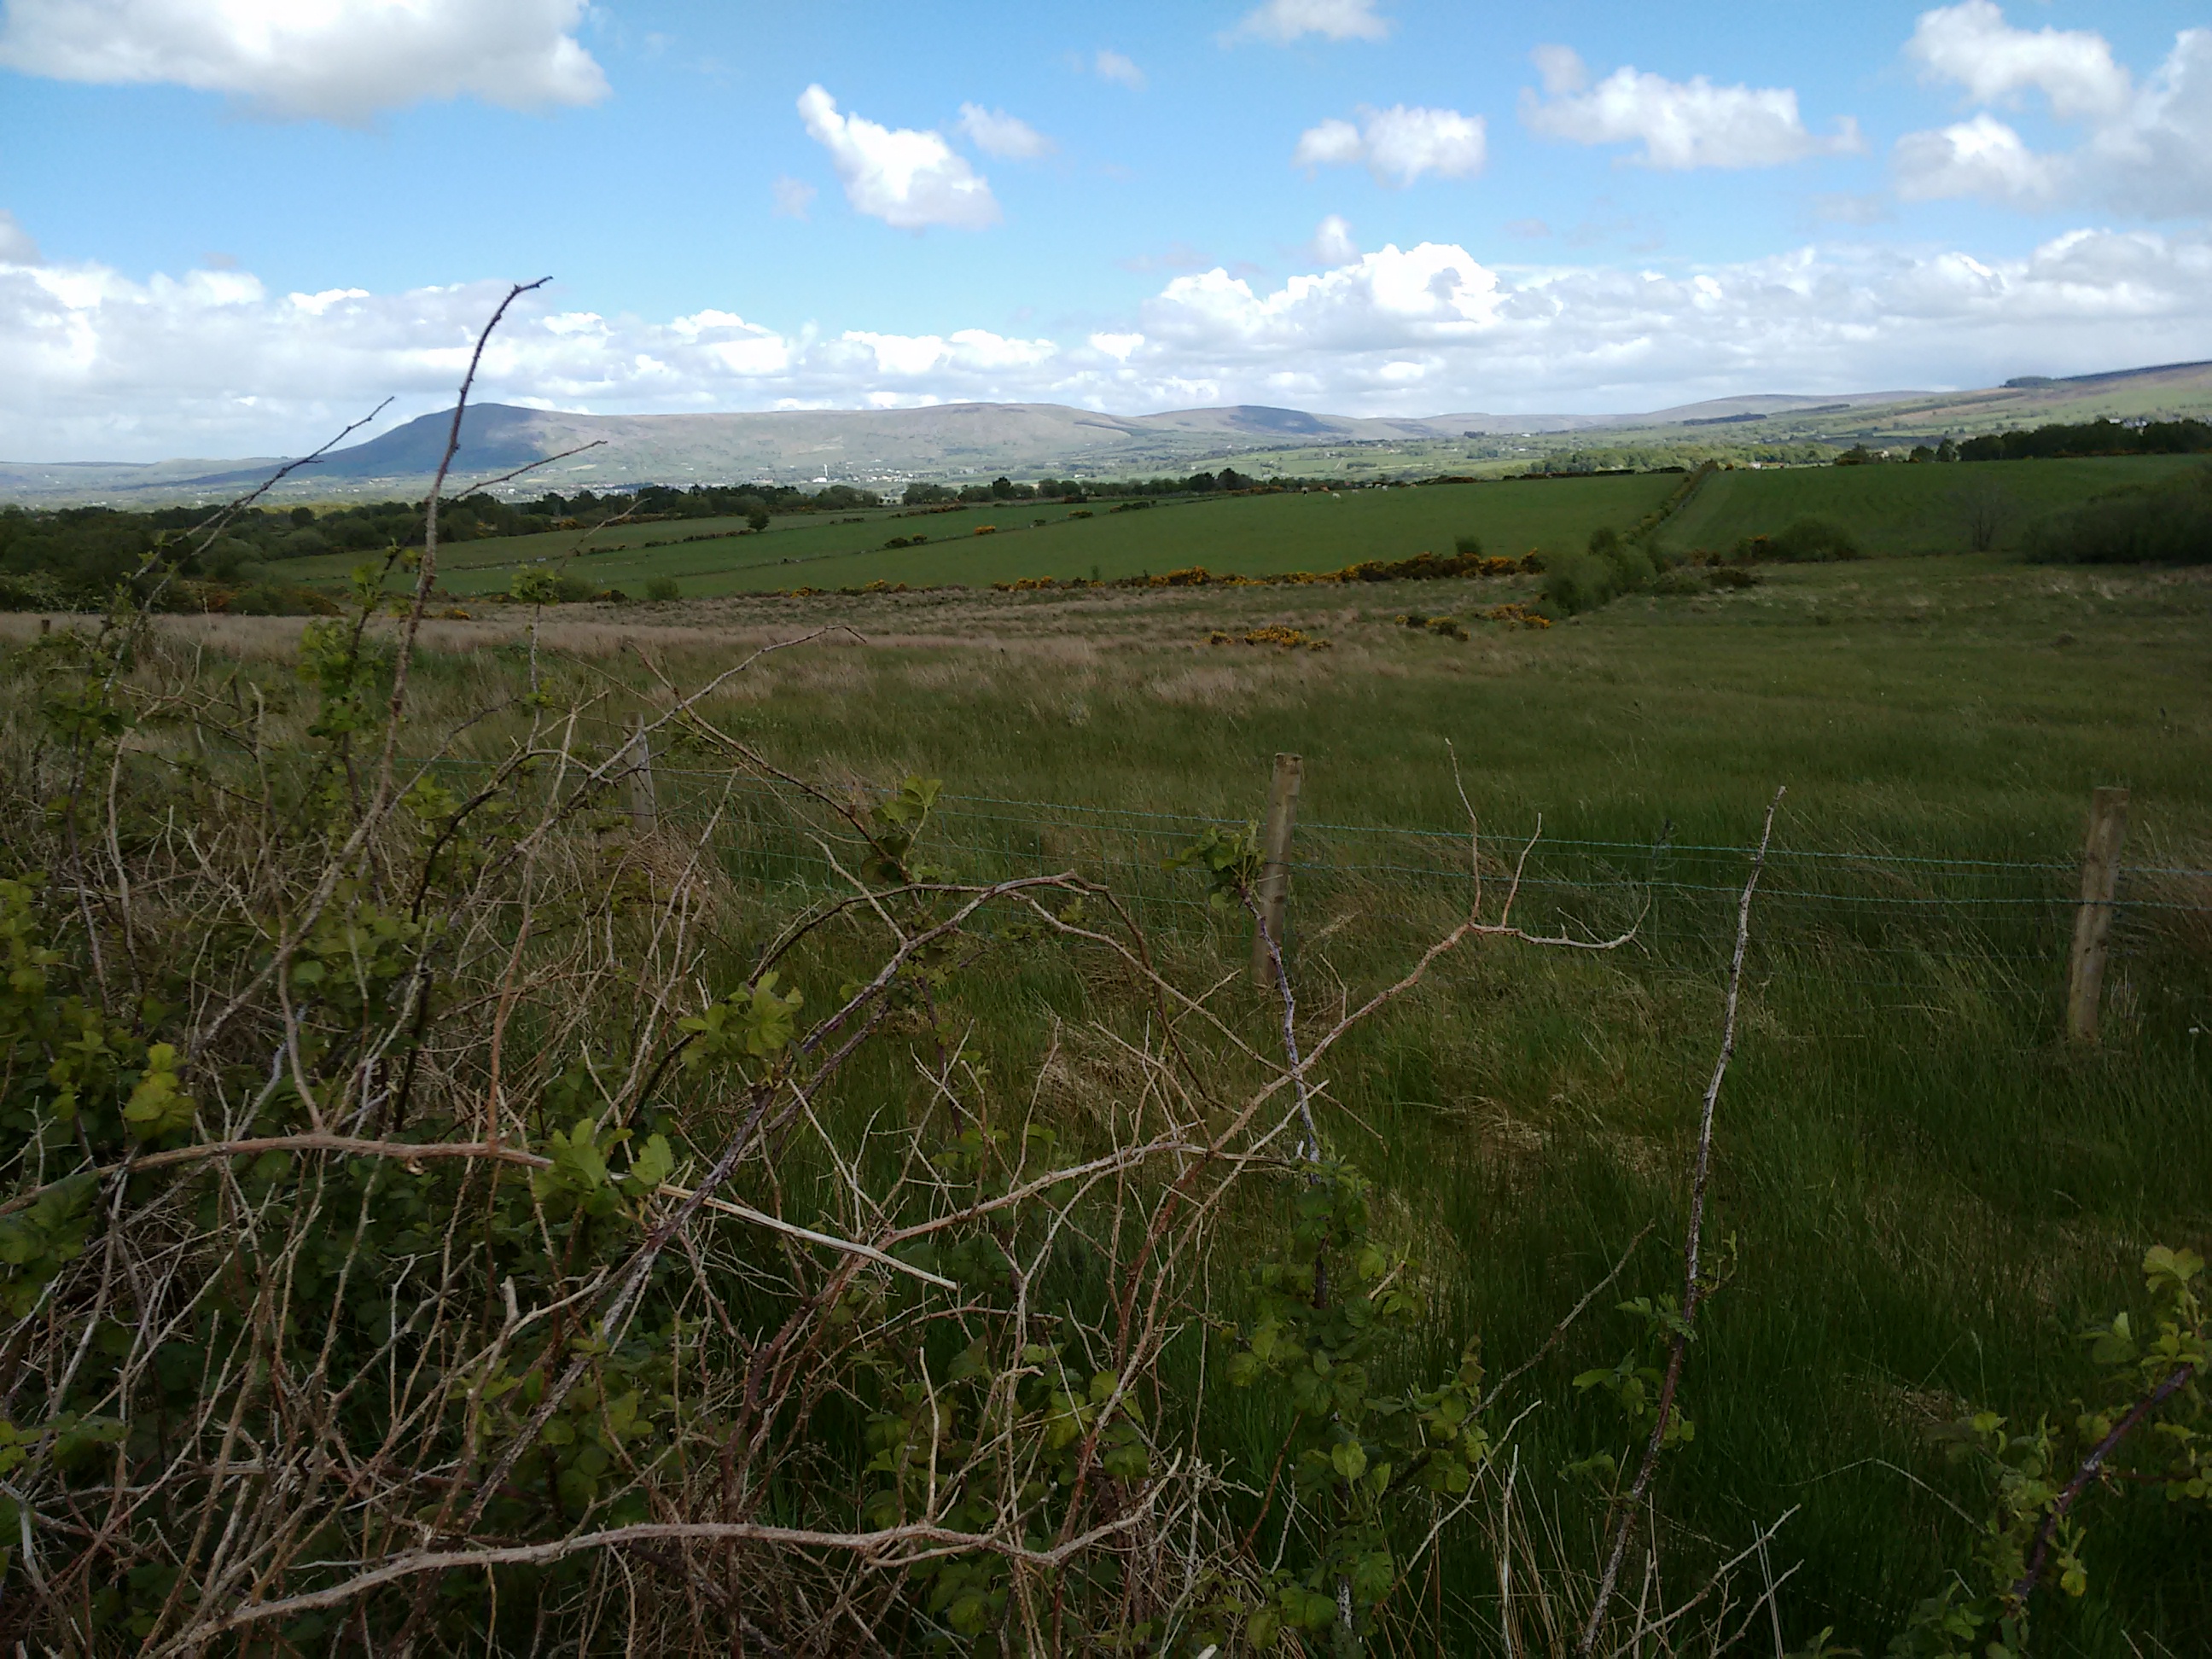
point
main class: Grassland
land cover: Grassland without tree/shrub cover
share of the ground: > 75 %
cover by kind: herbaceous plants 100 %
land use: Agriculture (excluding fallow land and kitchen gardens)
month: June
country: GB
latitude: 54.9114
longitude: -7.0003
